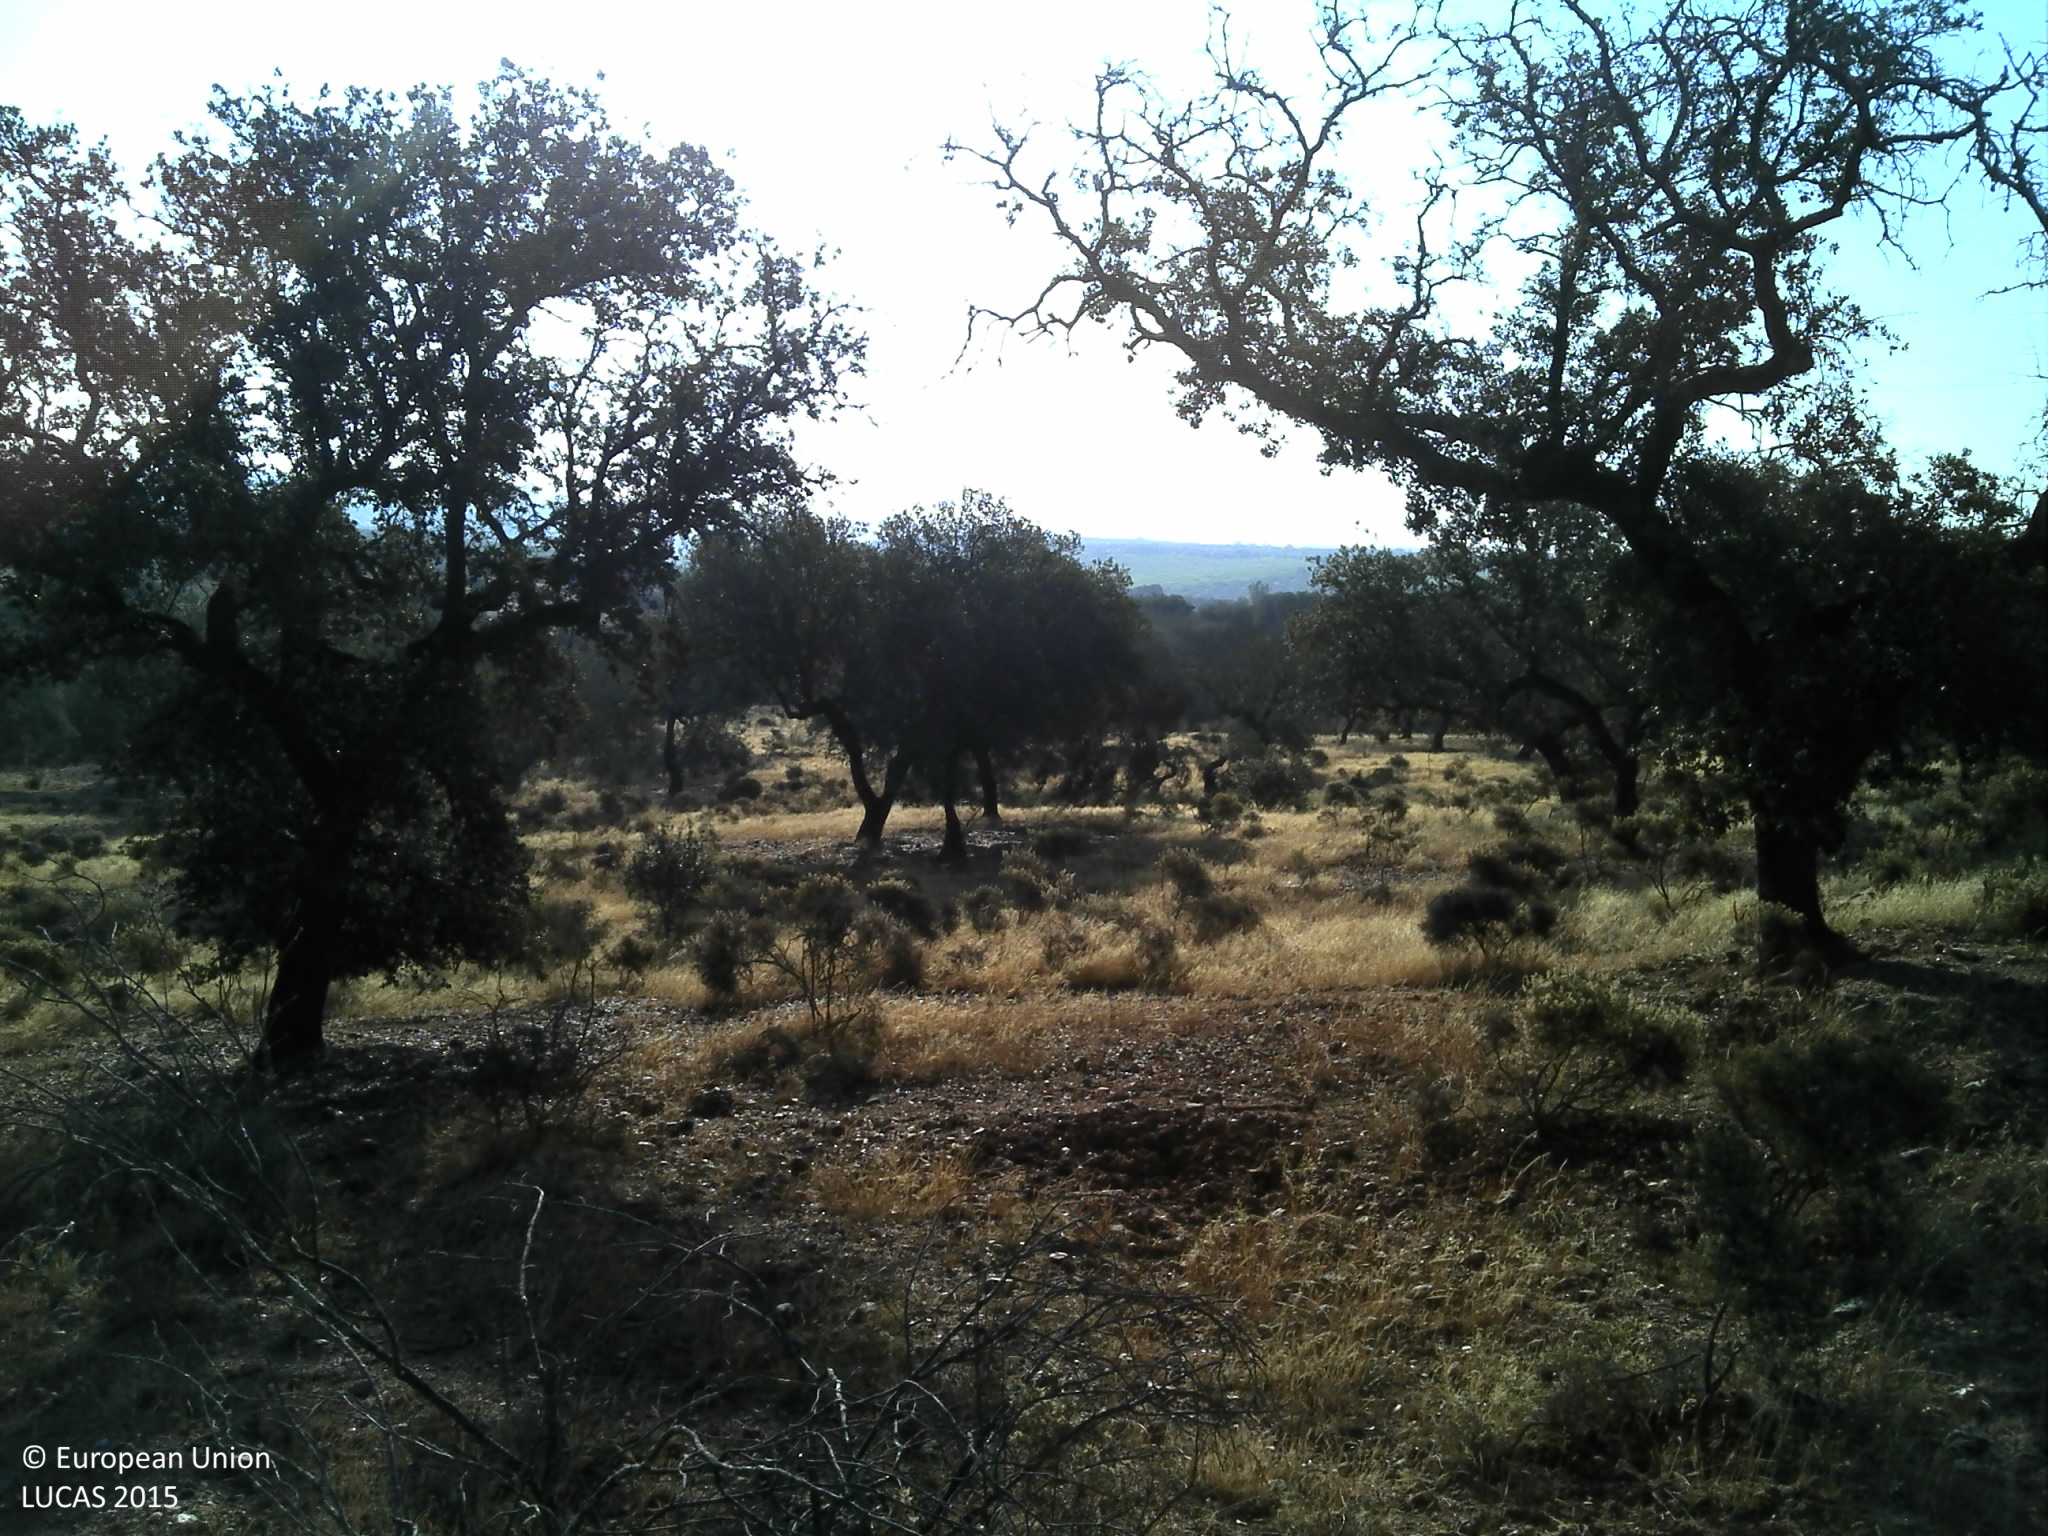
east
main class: Woodland
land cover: Broadleaved woodland
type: broadleaved evergreen forest
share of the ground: 10 - 25 %
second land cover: Shrubland without tree cover
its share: 25 - 50 %
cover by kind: shrubs 30 %, herbaceous plants 30 %, broadleaved forest trees 25 %, unconsolidated bare surface 15 %
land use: Forestry
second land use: Agriculture (excluding fallow land and kitchen gardens)
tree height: > 5 m
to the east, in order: Broadleaved woodland; Shrubland without tree cover; Broadleaved woodland; Fences; Broadleaved woodland; Rivers and streams; Broadleaved woodland
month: July
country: PT
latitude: 38.6062
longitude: -7.4025
